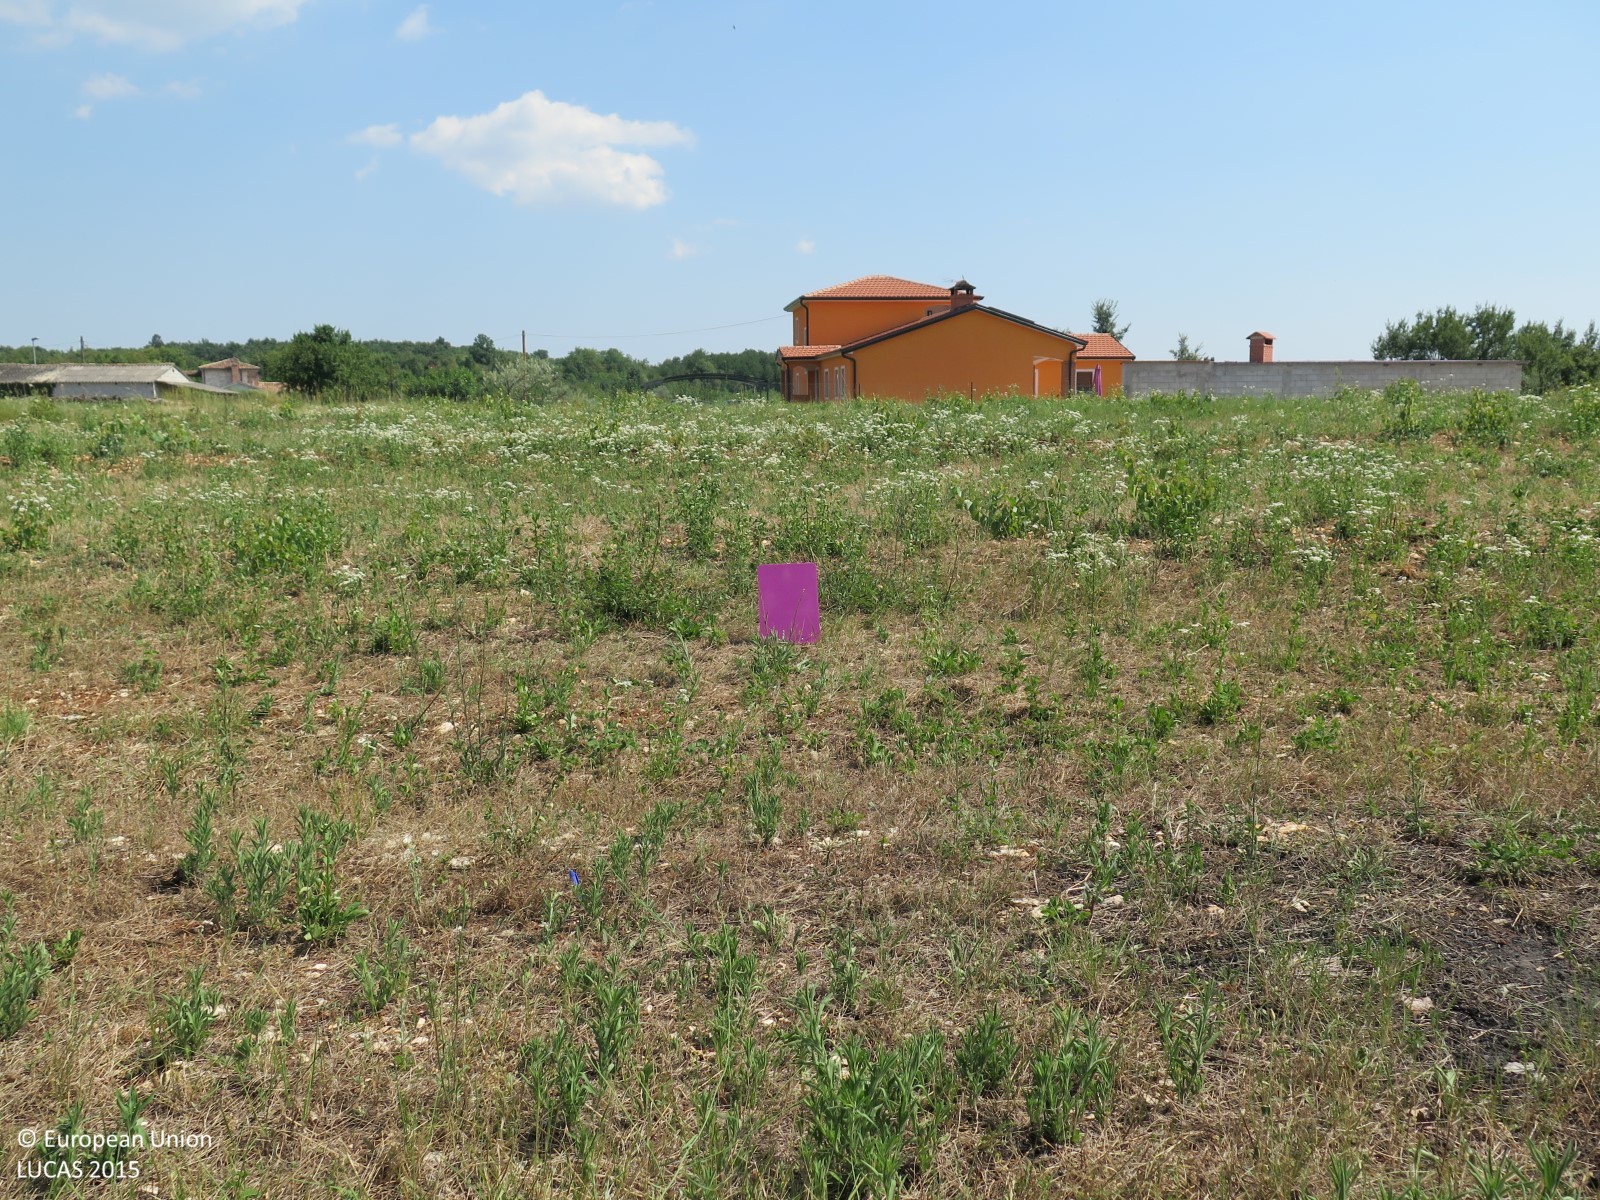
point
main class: Grassland
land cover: Grassland without tree/shrub cover
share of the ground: > 75 %
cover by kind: herbaceous plants 100 %
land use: Abandoned areas
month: July
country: HR
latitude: 45.1654
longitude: 13.7987
